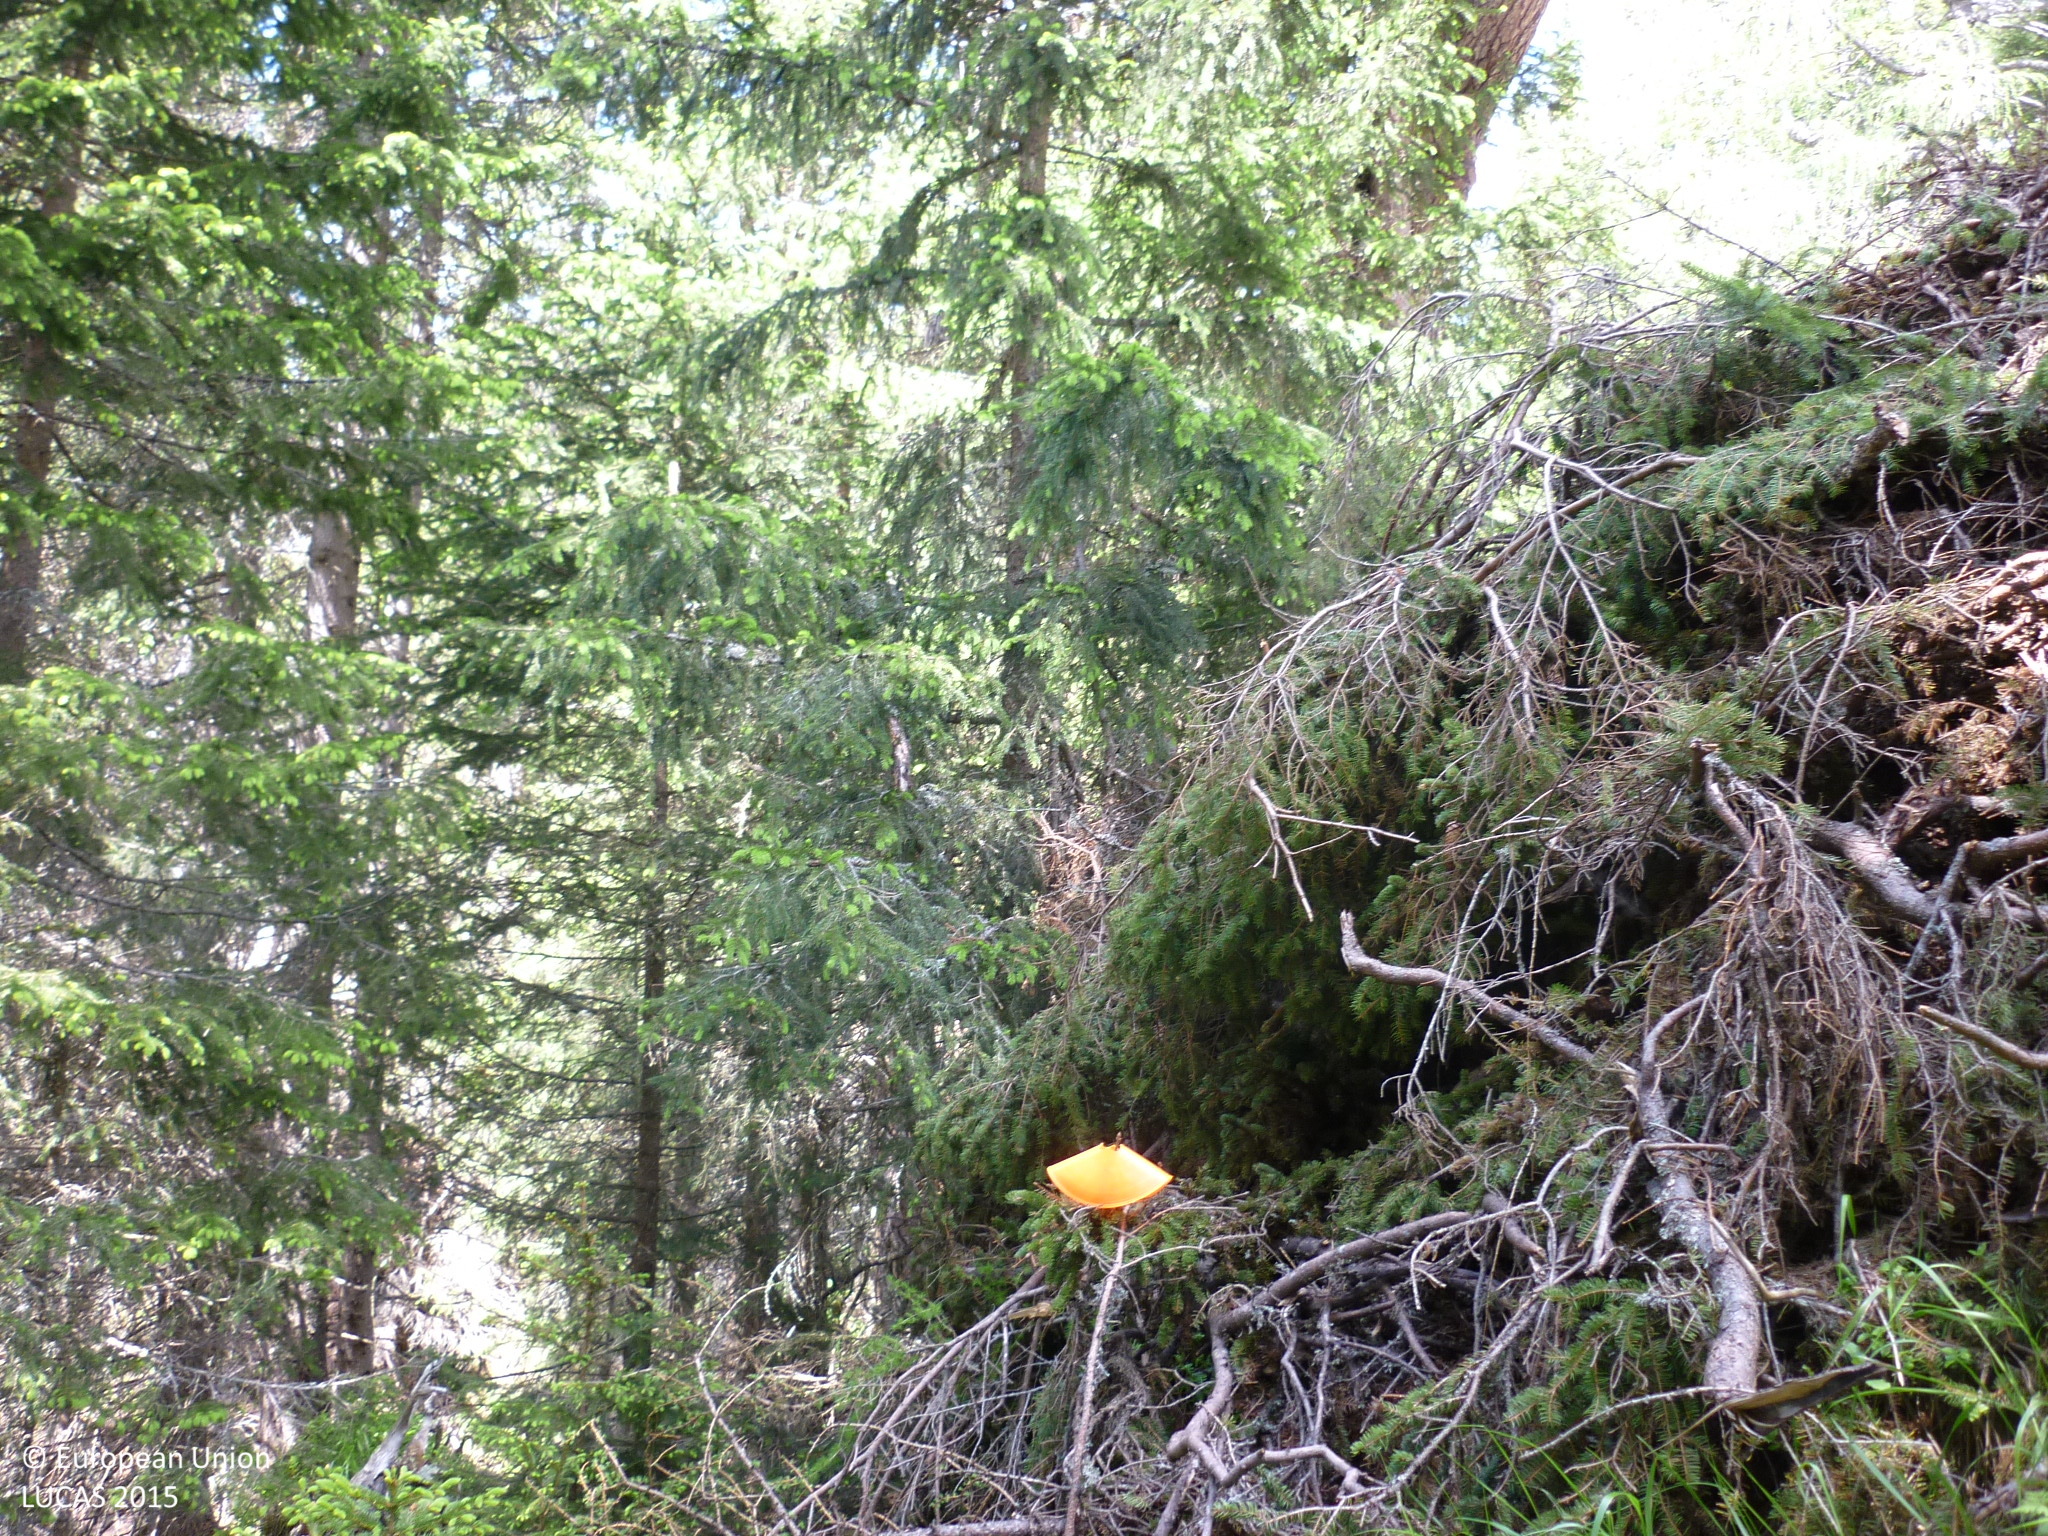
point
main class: Woodland
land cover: Spruce dominated coniferous woodland
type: alpine coniferous forest
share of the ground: > 75 %
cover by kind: coniferous forest trees 80 %, herbaceous plants 15 %, unconsolidated bare surface 5 %
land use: Forestry
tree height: > 5 m
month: June
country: AT
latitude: 47.2537
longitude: 14.3723
